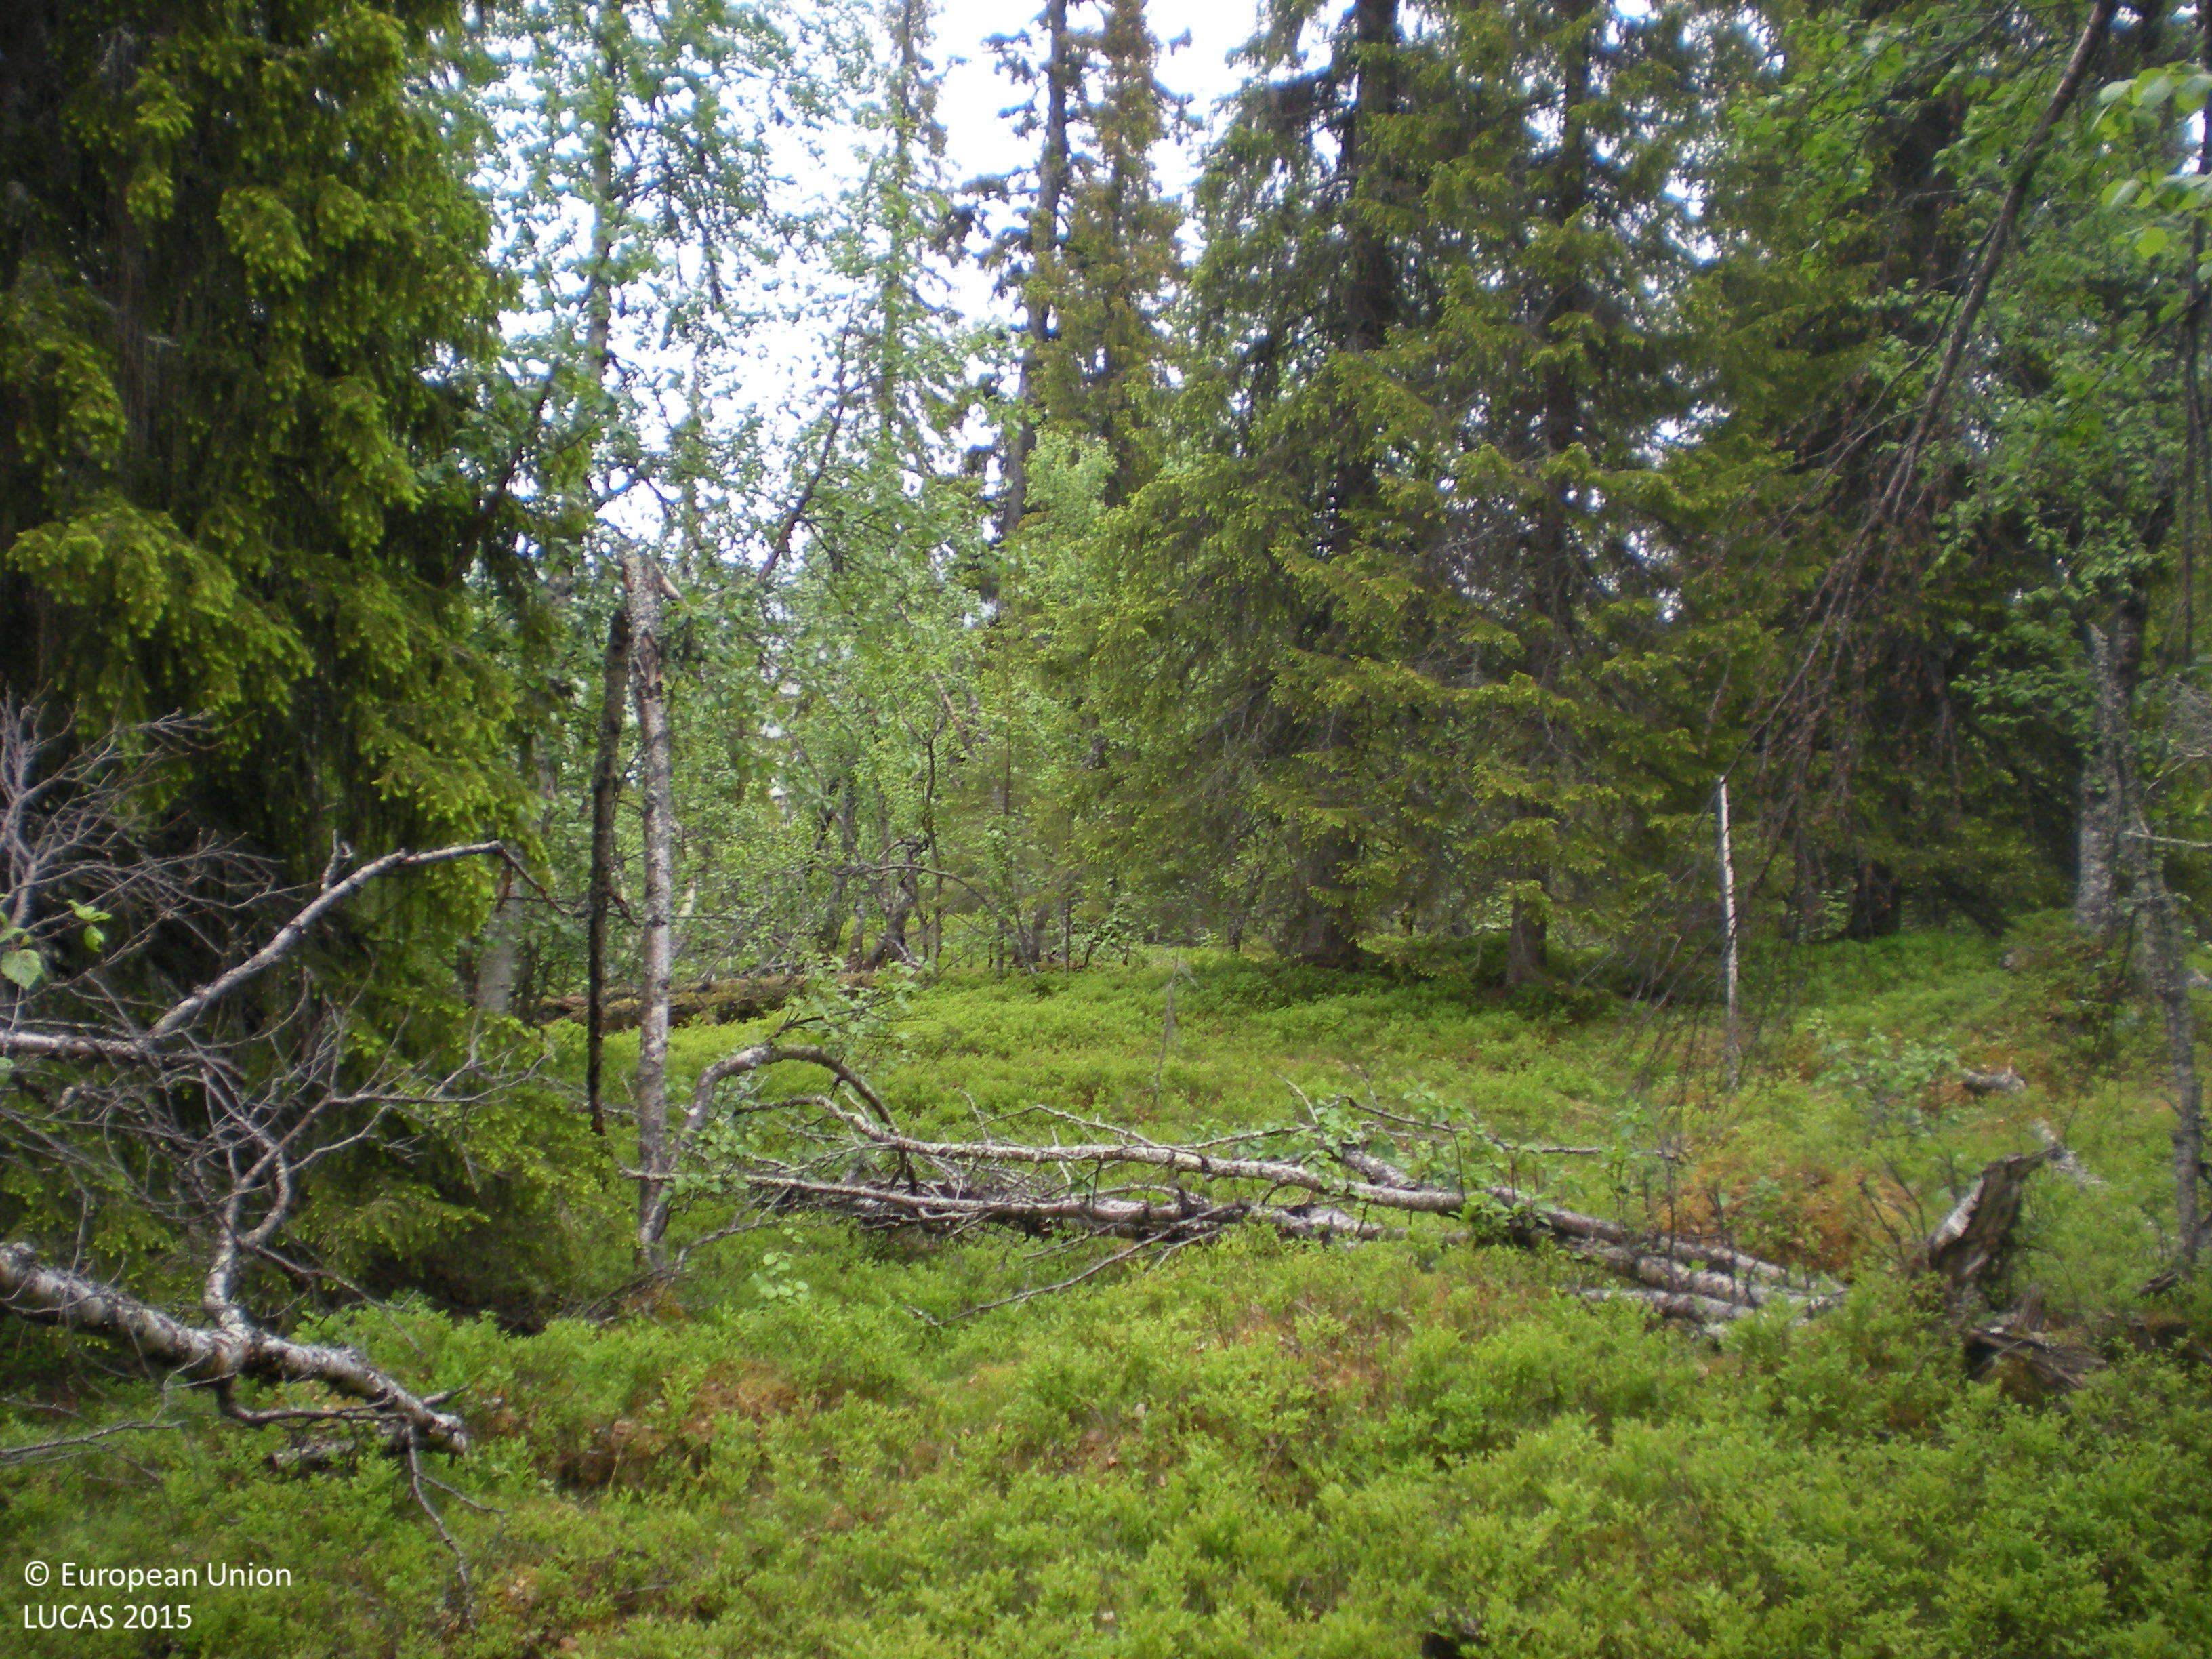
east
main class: Woodland
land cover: Spruce dominated mixed woodland
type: boreal forest
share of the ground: 50 - 75 %
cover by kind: coniferous forest trees 55 %, broadleaved forest trees 20 %, shrubs 20 %, lichens and mosses 5 %
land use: Semi-natural and natural areas not in use
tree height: > 5 m
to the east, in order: Spruce dominated mixed woodland; Spruce dominated coniferous woodland
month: July
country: SE
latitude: 66.1214
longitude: 17.2390
